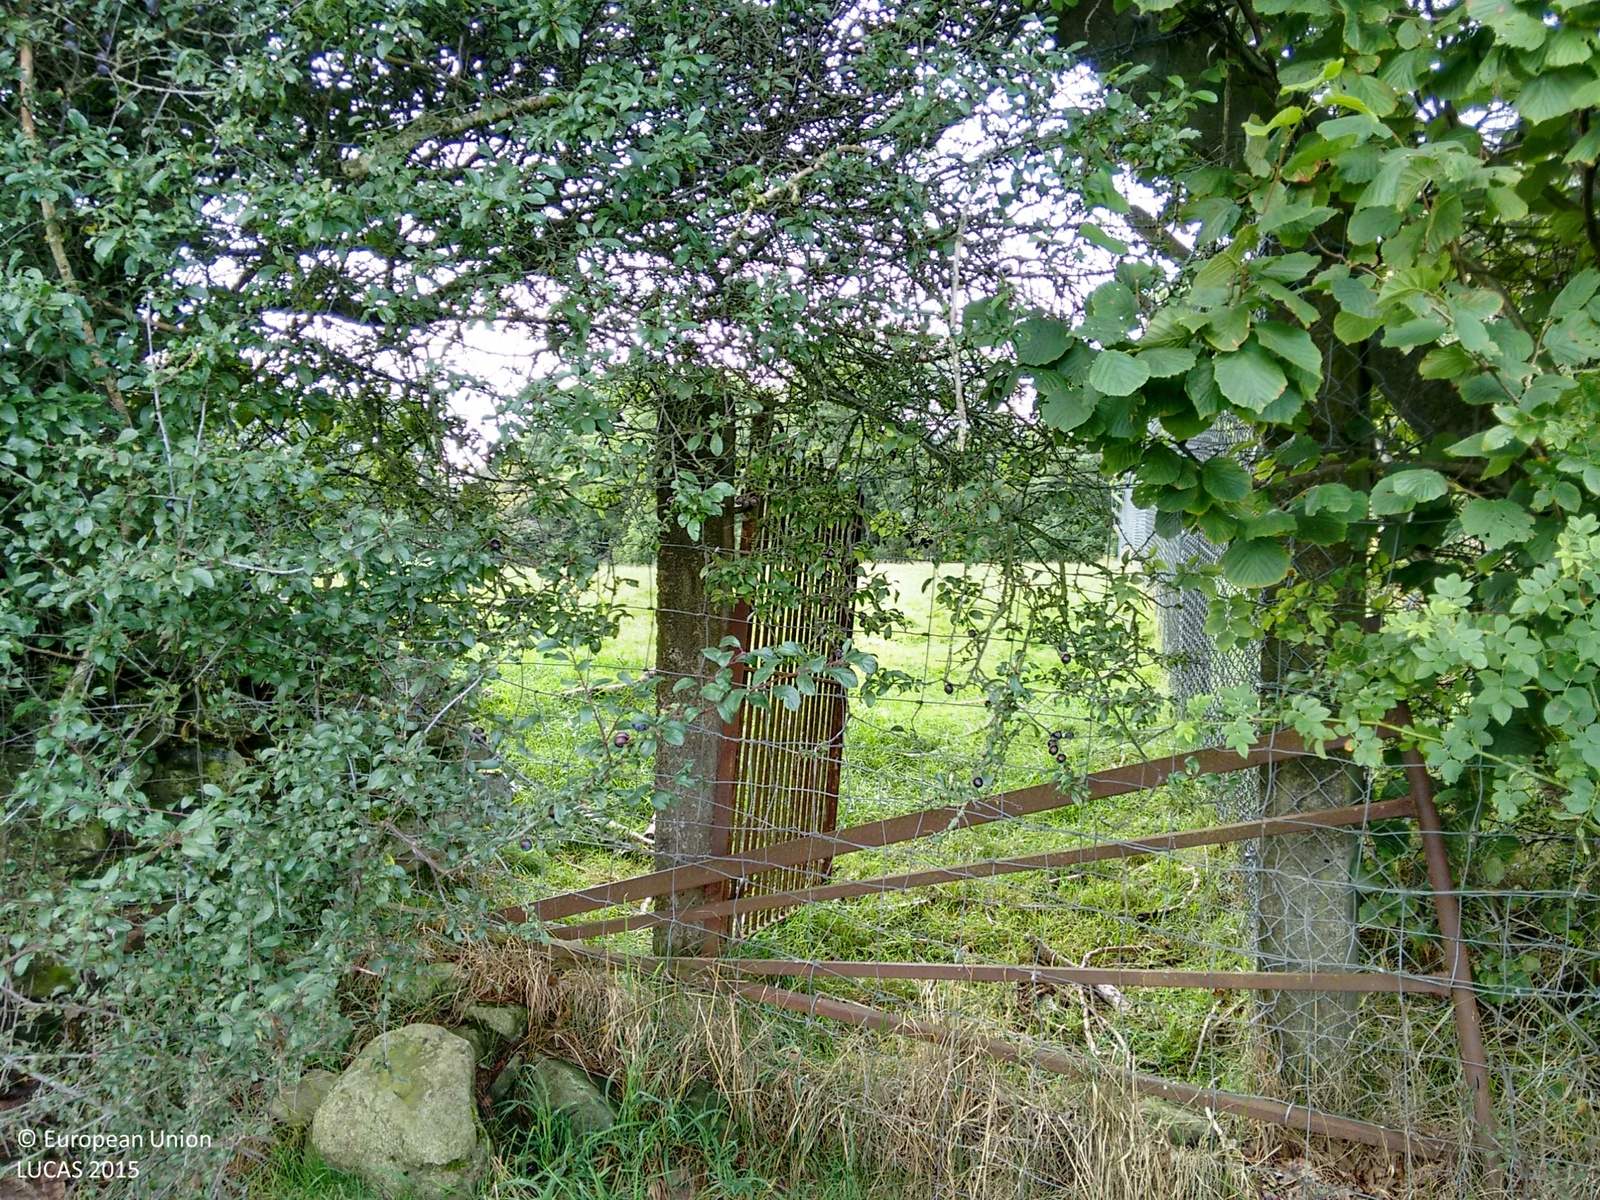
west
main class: Grassland
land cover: Grassland without tree/shrub cover
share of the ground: > 75 %
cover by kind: herbaceous plants 100 %
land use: Agriculture (excluding fallow land and kitchen gardens)
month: September
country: GB
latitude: 52.1214
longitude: -4.0437
